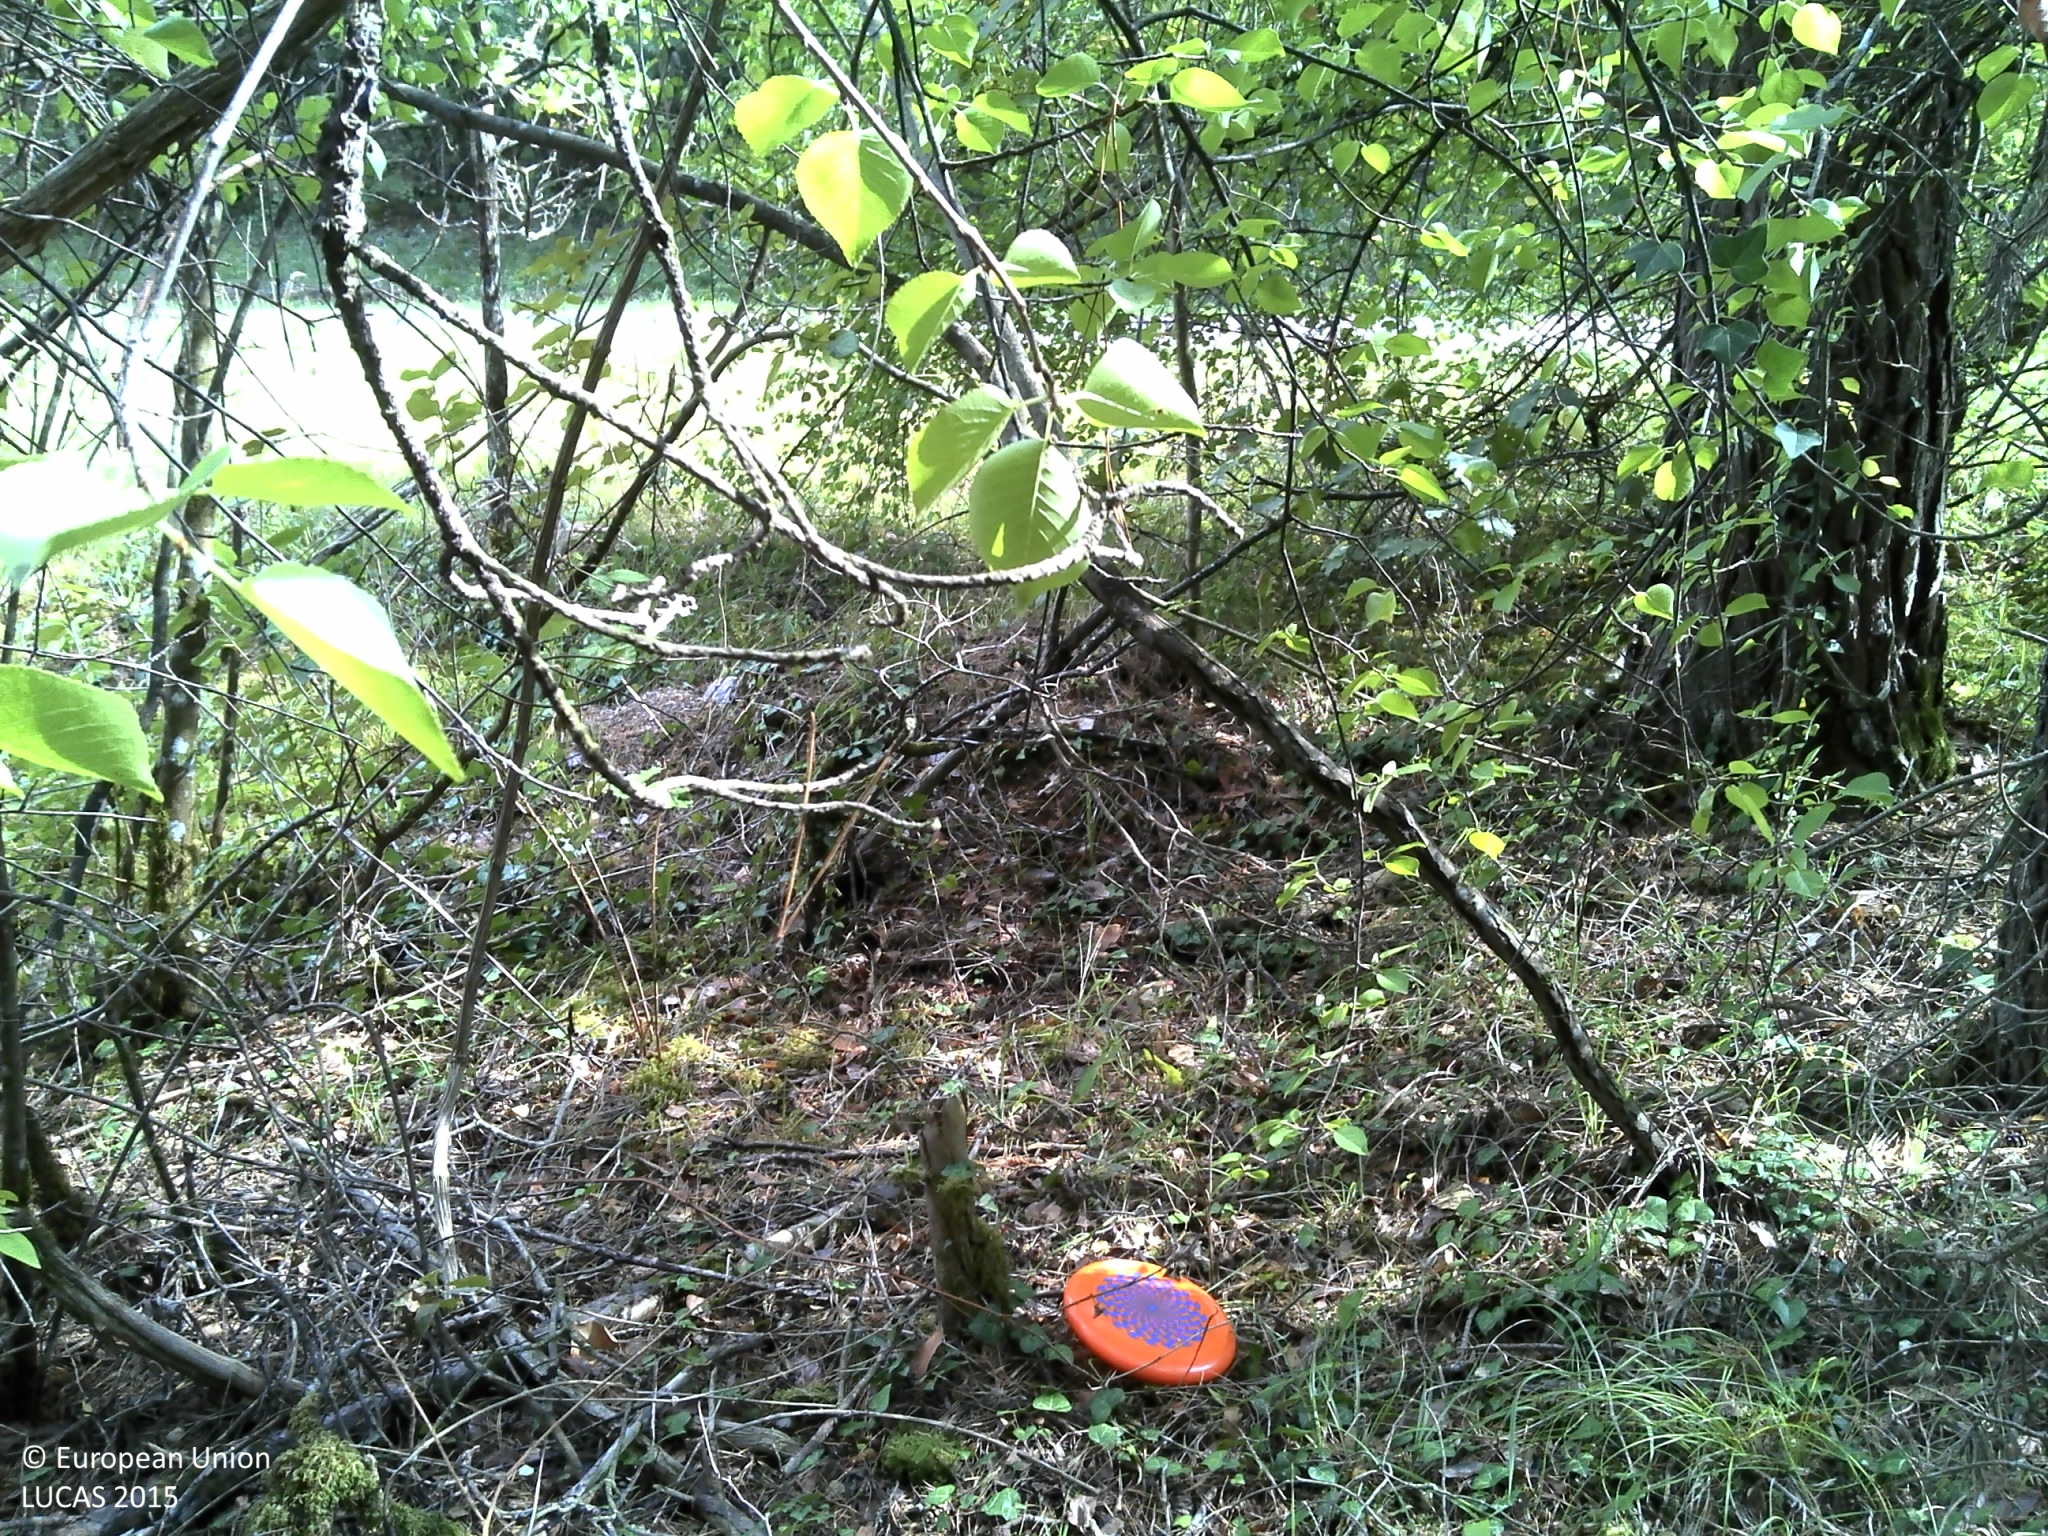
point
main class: Woodland
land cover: Pine dominated mixed woodland
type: mesophytic deciduous forest
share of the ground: > 75 %
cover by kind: coniferous forest trees 45 %, broadleaved forest trees 35 %, lichens and mosses 10 %, shrubs 5 %, herbaceous plants 5 %
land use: Forestry
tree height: > 5 m
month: September
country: FR
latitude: 47.9085
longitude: 4.9285
